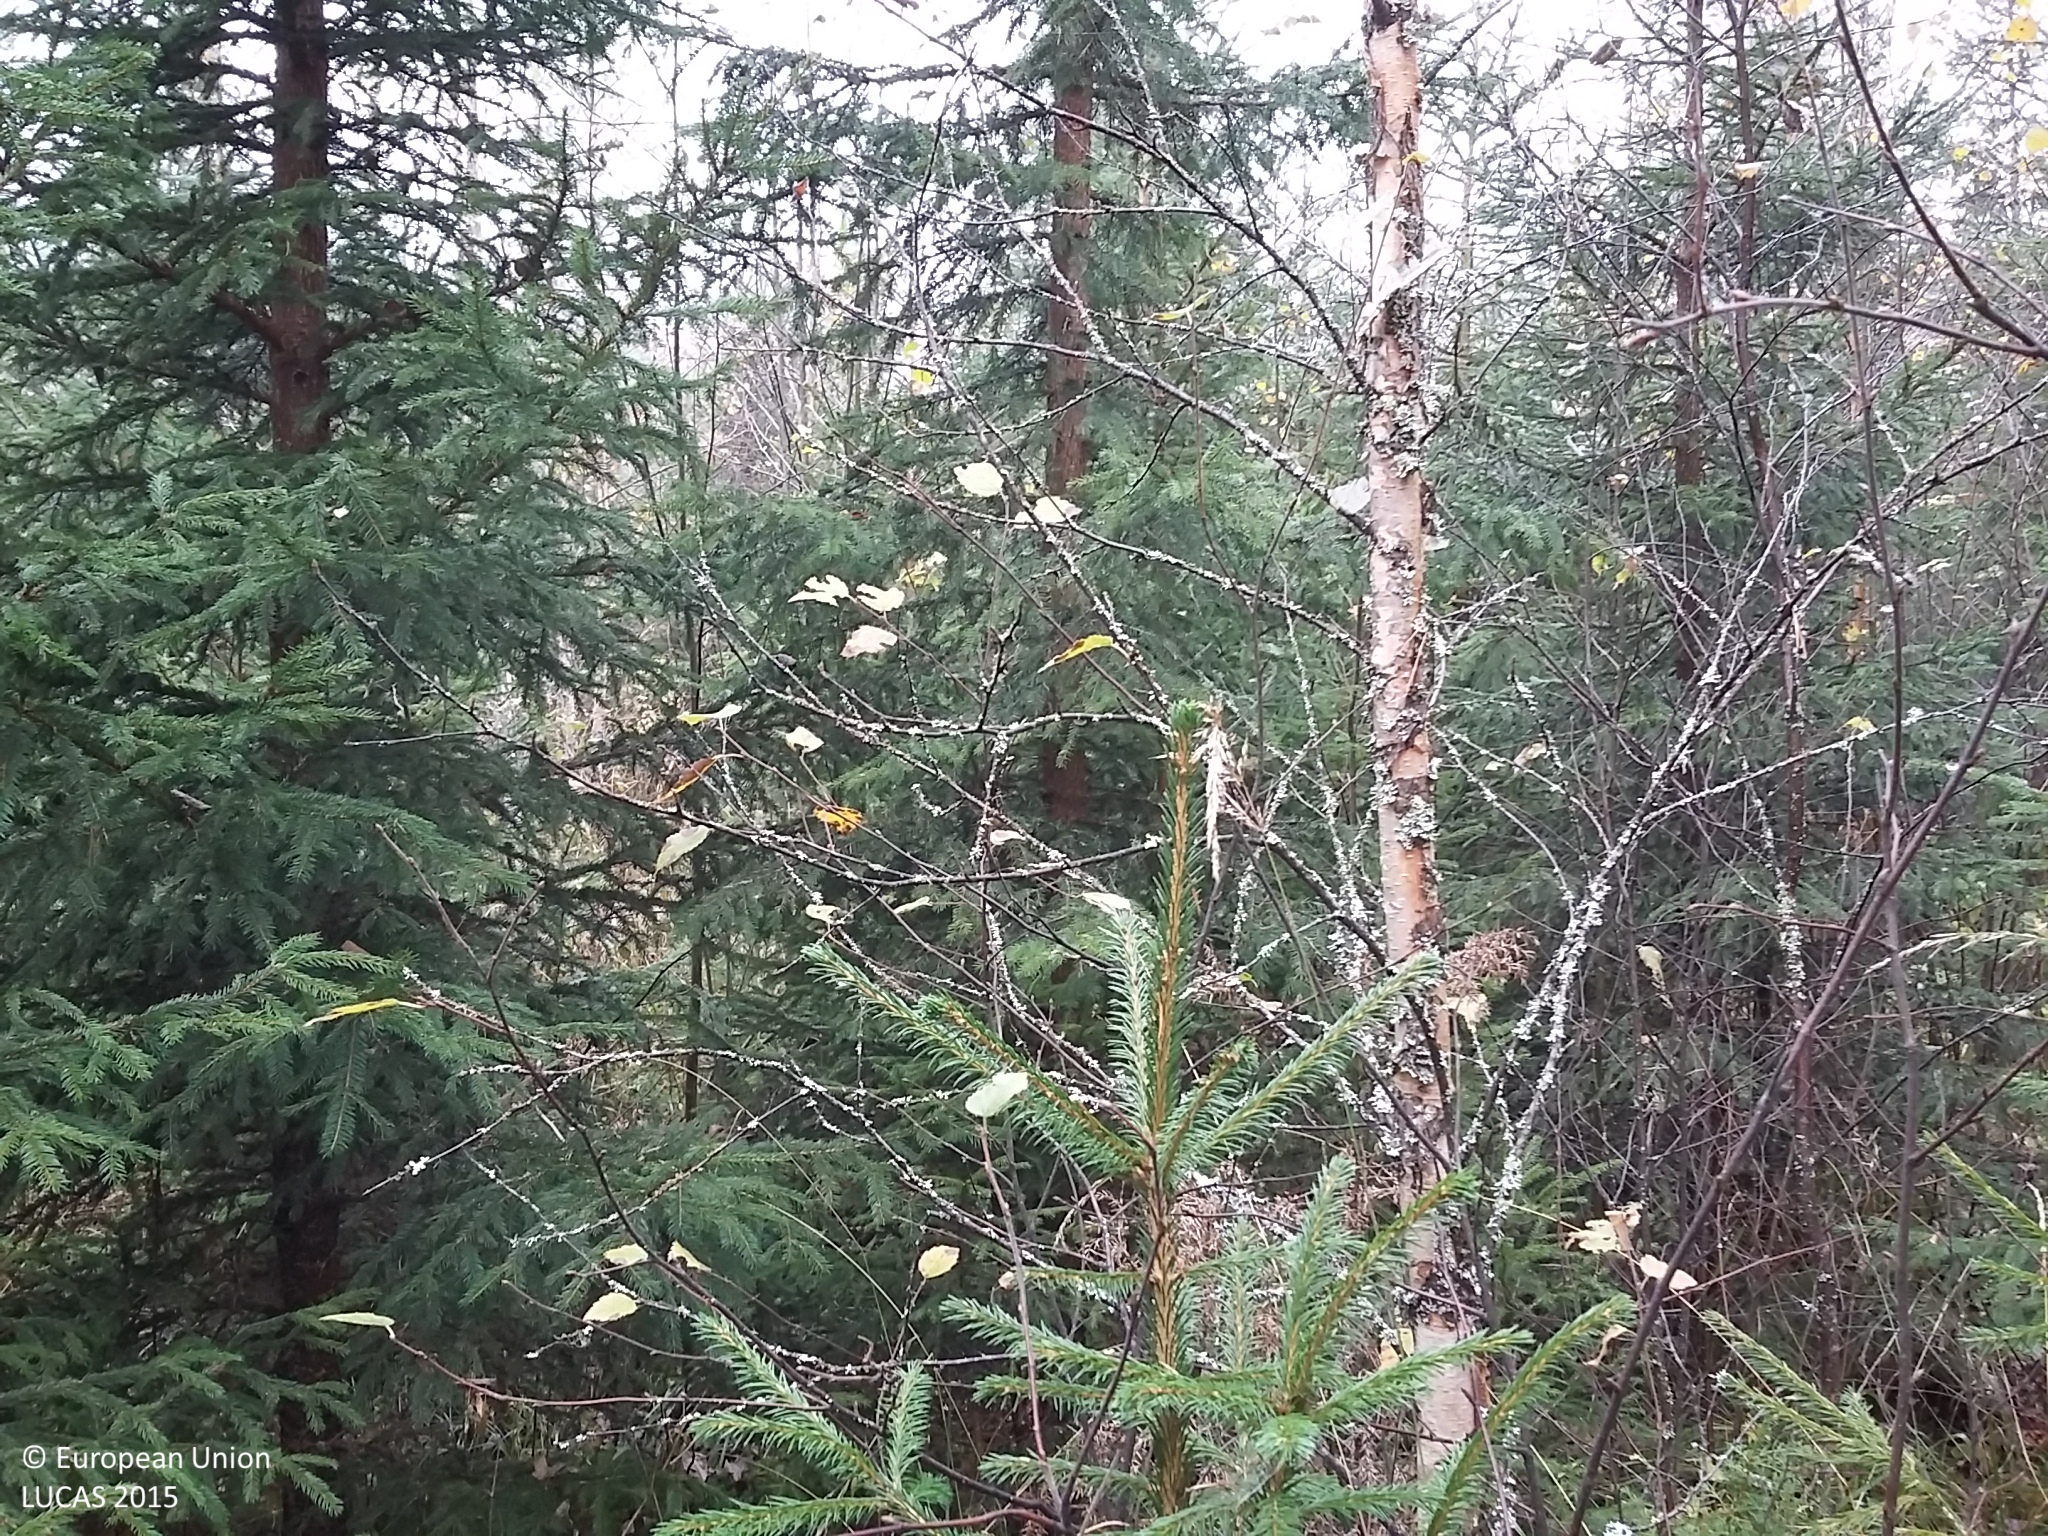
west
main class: Woodland
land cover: Spruce dominated mixed woodland
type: hemiboreal forest and nemoral coniferous forest and mixed broadleaved-coniferous forest
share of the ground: > 75 %
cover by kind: coniferous forest trees 65 %, broadleaved forest trees 25 %, herbaceous plants 5 %, lichens and mosses 5 %
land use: Forestry
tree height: > 5 m
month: October
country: FI
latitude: 62.6046
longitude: 26.2800
